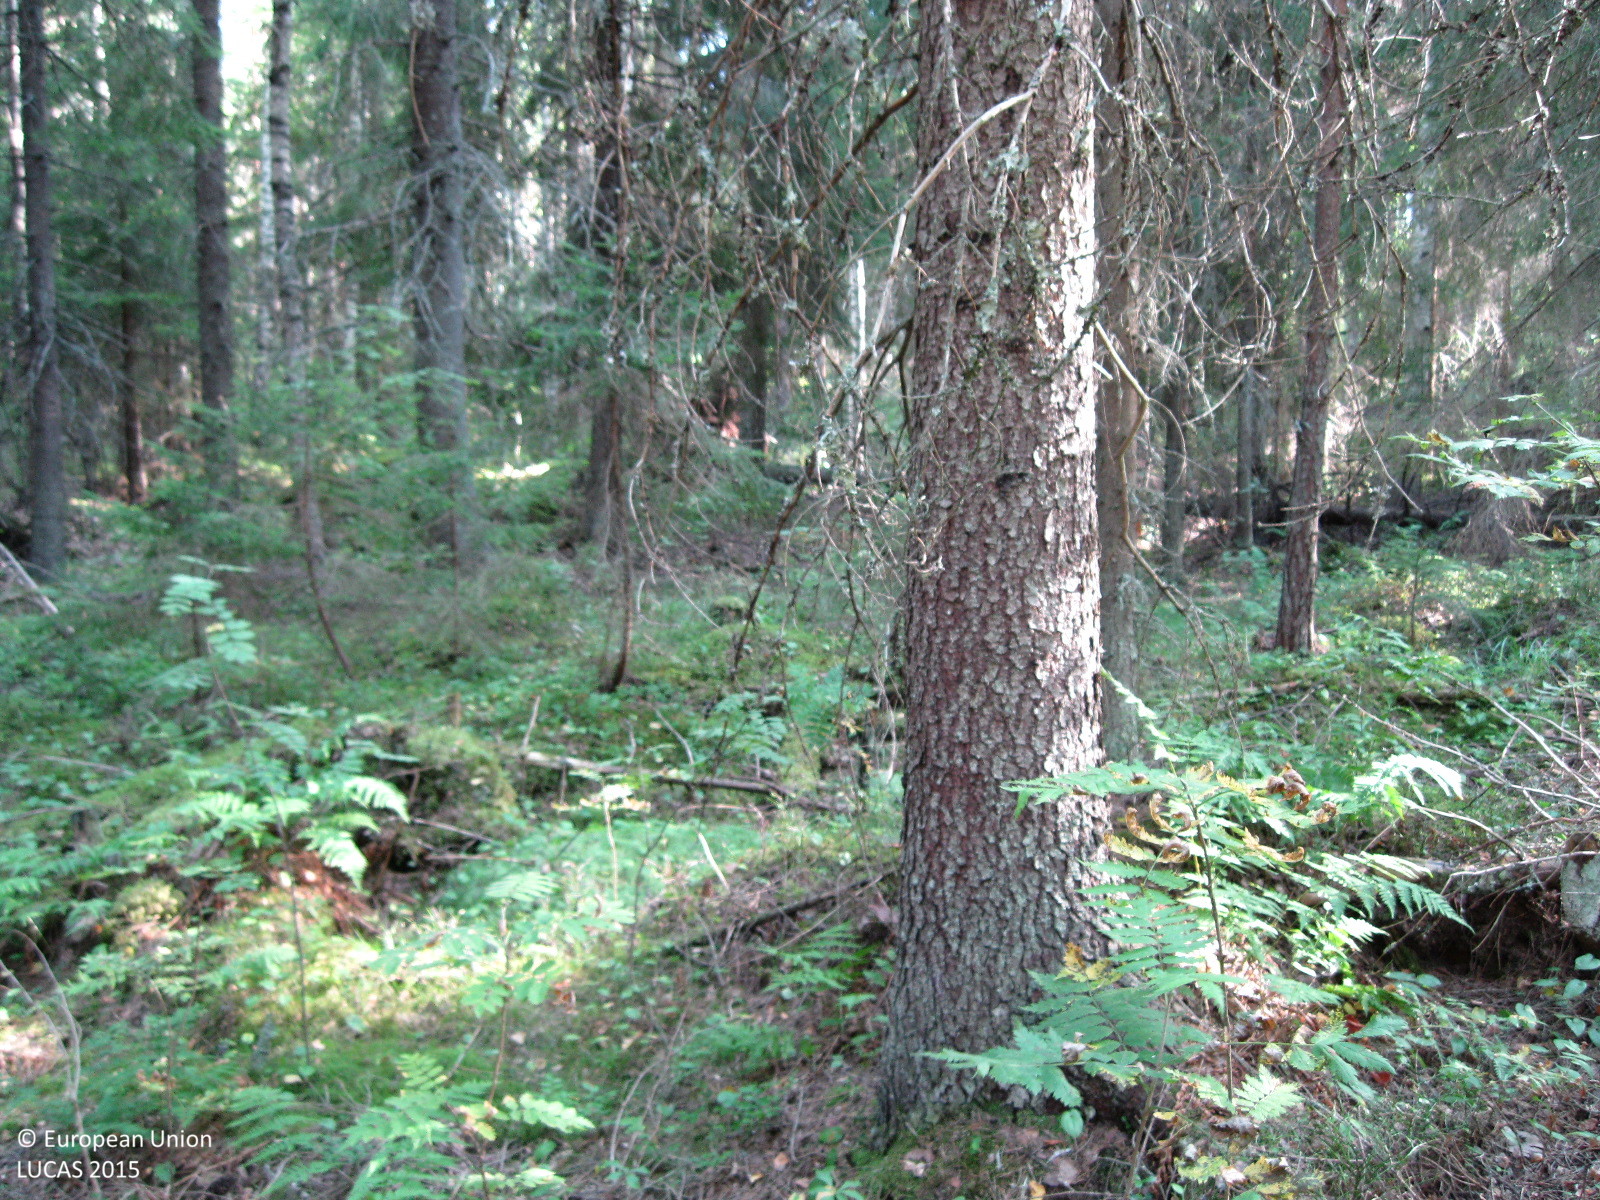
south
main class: Woodland
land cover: Spruce dominated mixed woodland
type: boreal forest
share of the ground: > 75 %
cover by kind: coniferous forest trees 65 %, broadleaved forest trees 25 %, herbaceous plants 10 %
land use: Forestry
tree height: > 5 m
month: August
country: FI
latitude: 61.2689
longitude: 25.3173
